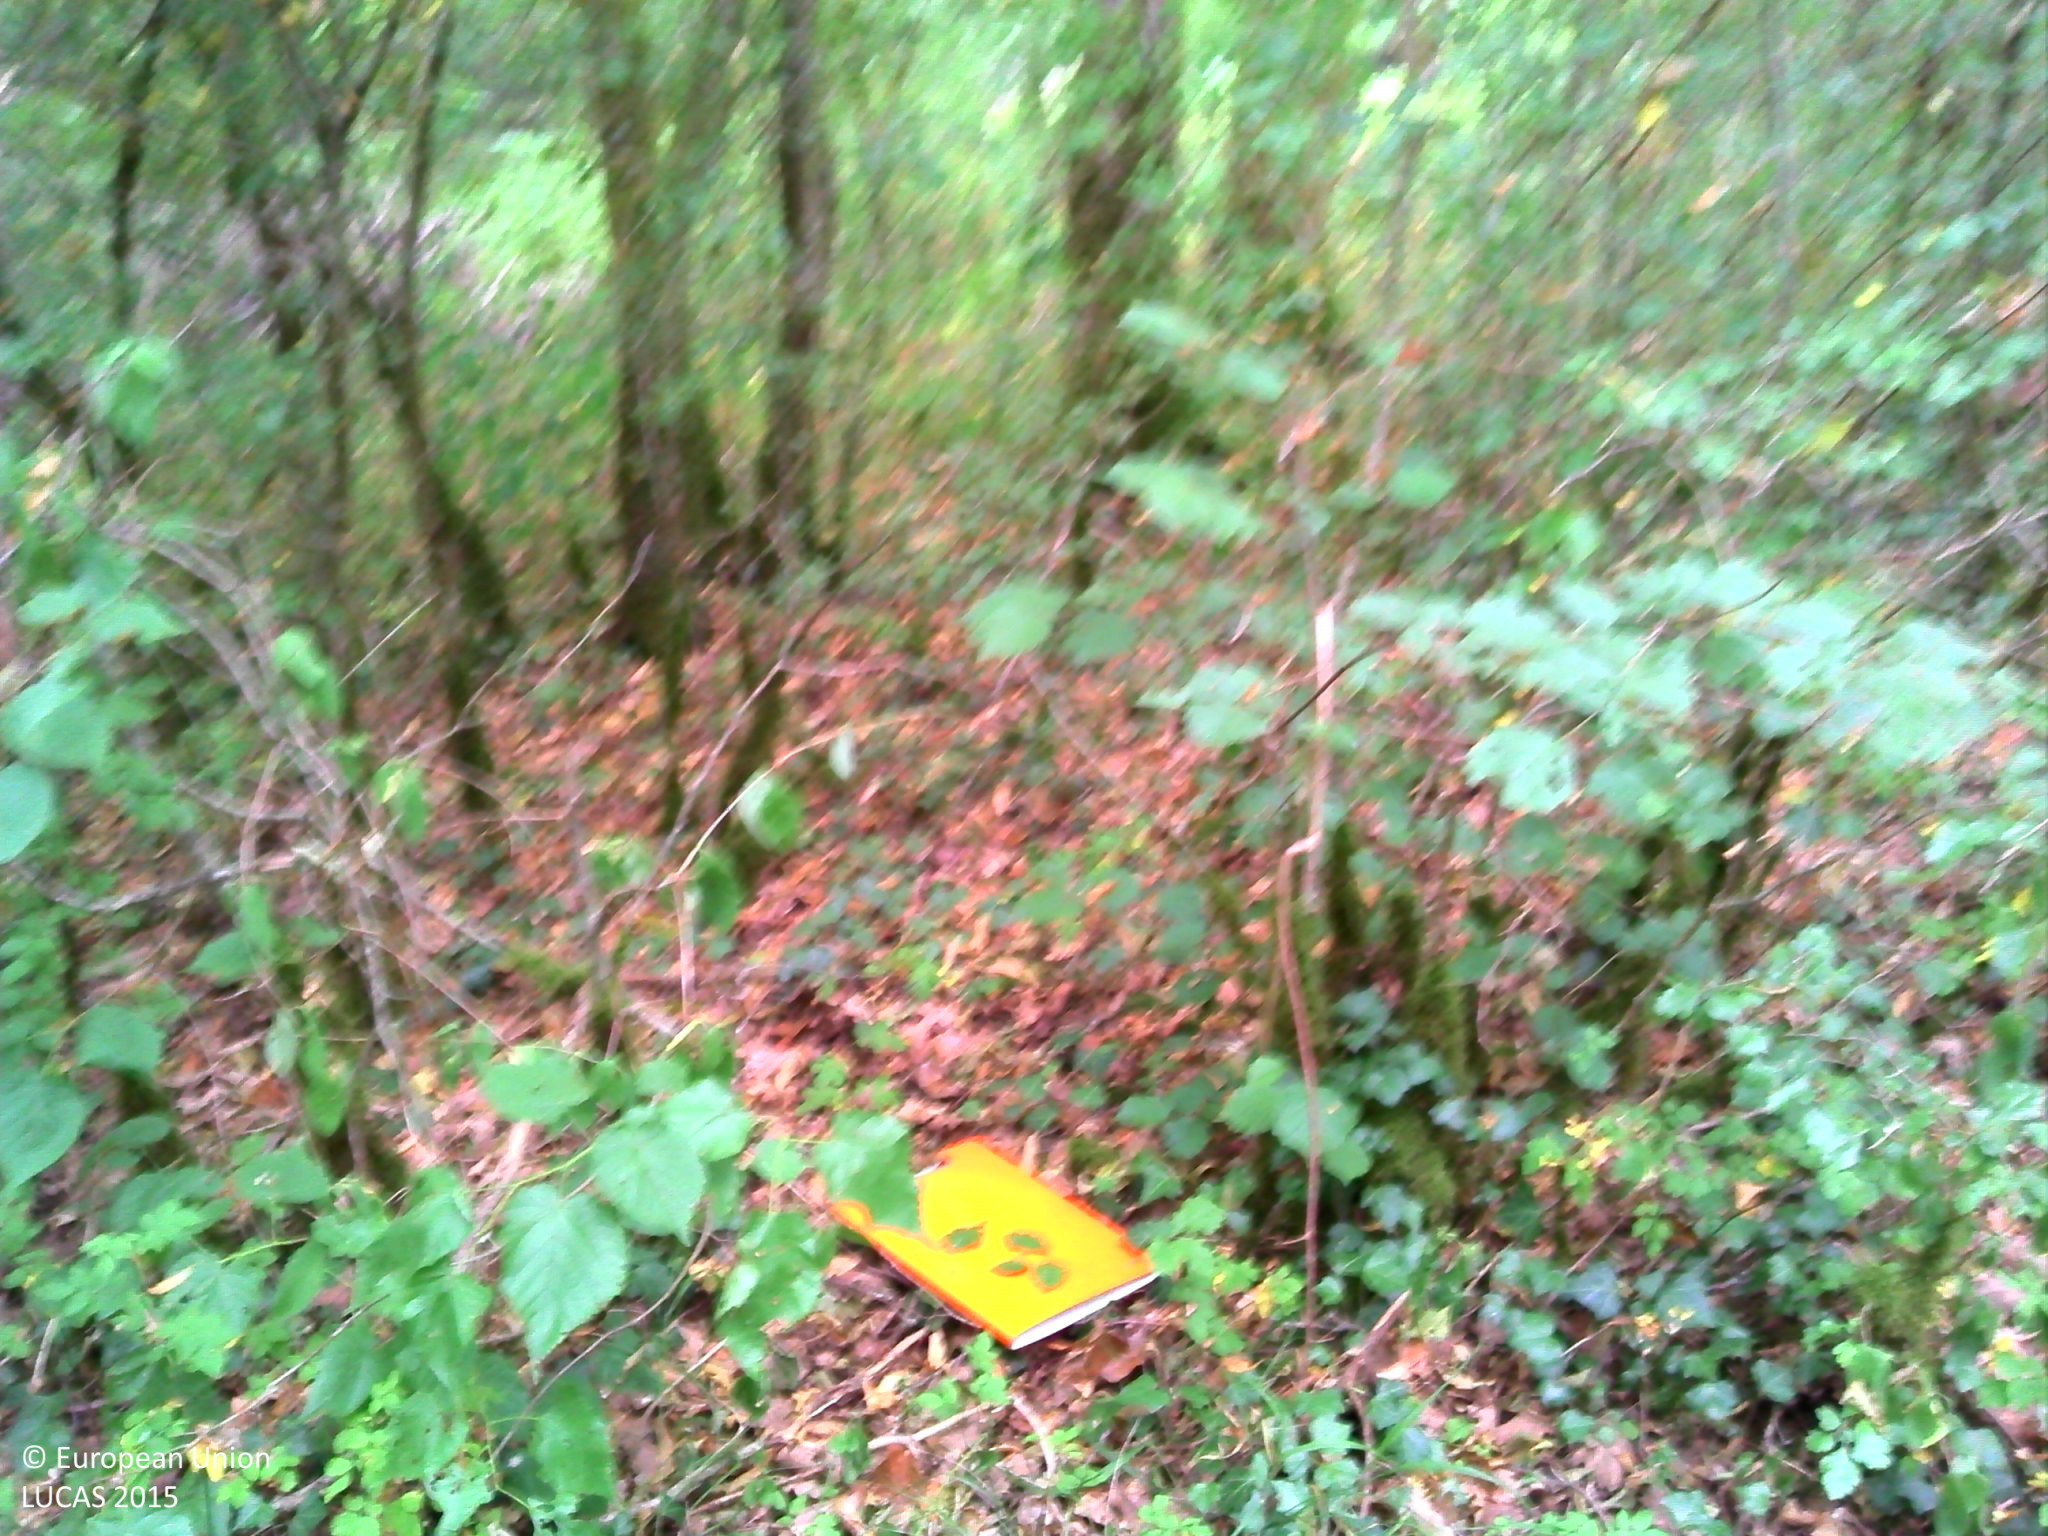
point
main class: Woodland
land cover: Broadleaved woodland
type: mesophytic deciduous forest
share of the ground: > 75 %
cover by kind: broadleaved forest trees 80 %, herbaceous plants 10 %, lichens and mosses 10 %
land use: Forestry
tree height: > 5 m
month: July
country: FR
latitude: 47.9408
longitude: 5.2472
